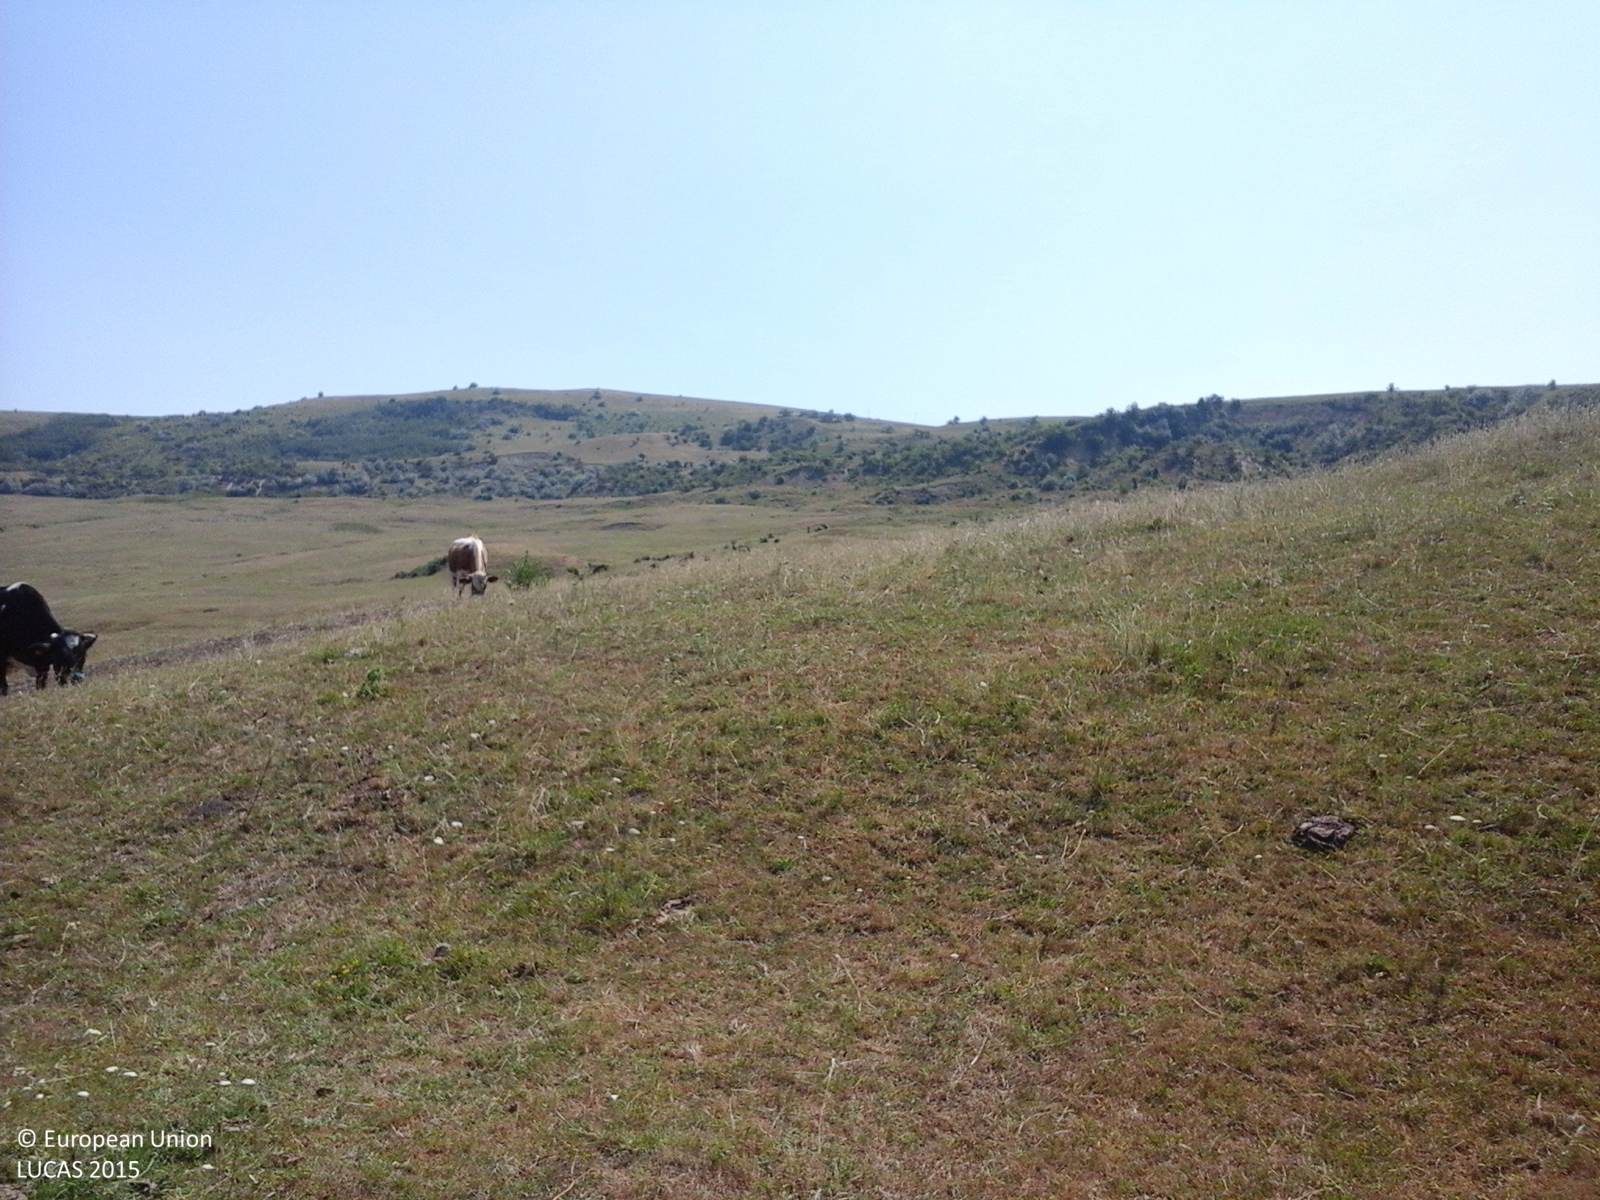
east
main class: Grassland
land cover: Grassland without tree/shrub cover
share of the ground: > 75 %
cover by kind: herbaceous plants 100 %
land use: Agriculture (excluding fallow land and kitchen gardens)
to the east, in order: Grassland without tree/shrub cover; Grassland with sparse tree/shrub cover
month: June
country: RO
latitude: 46.9358
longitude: 27.8446
